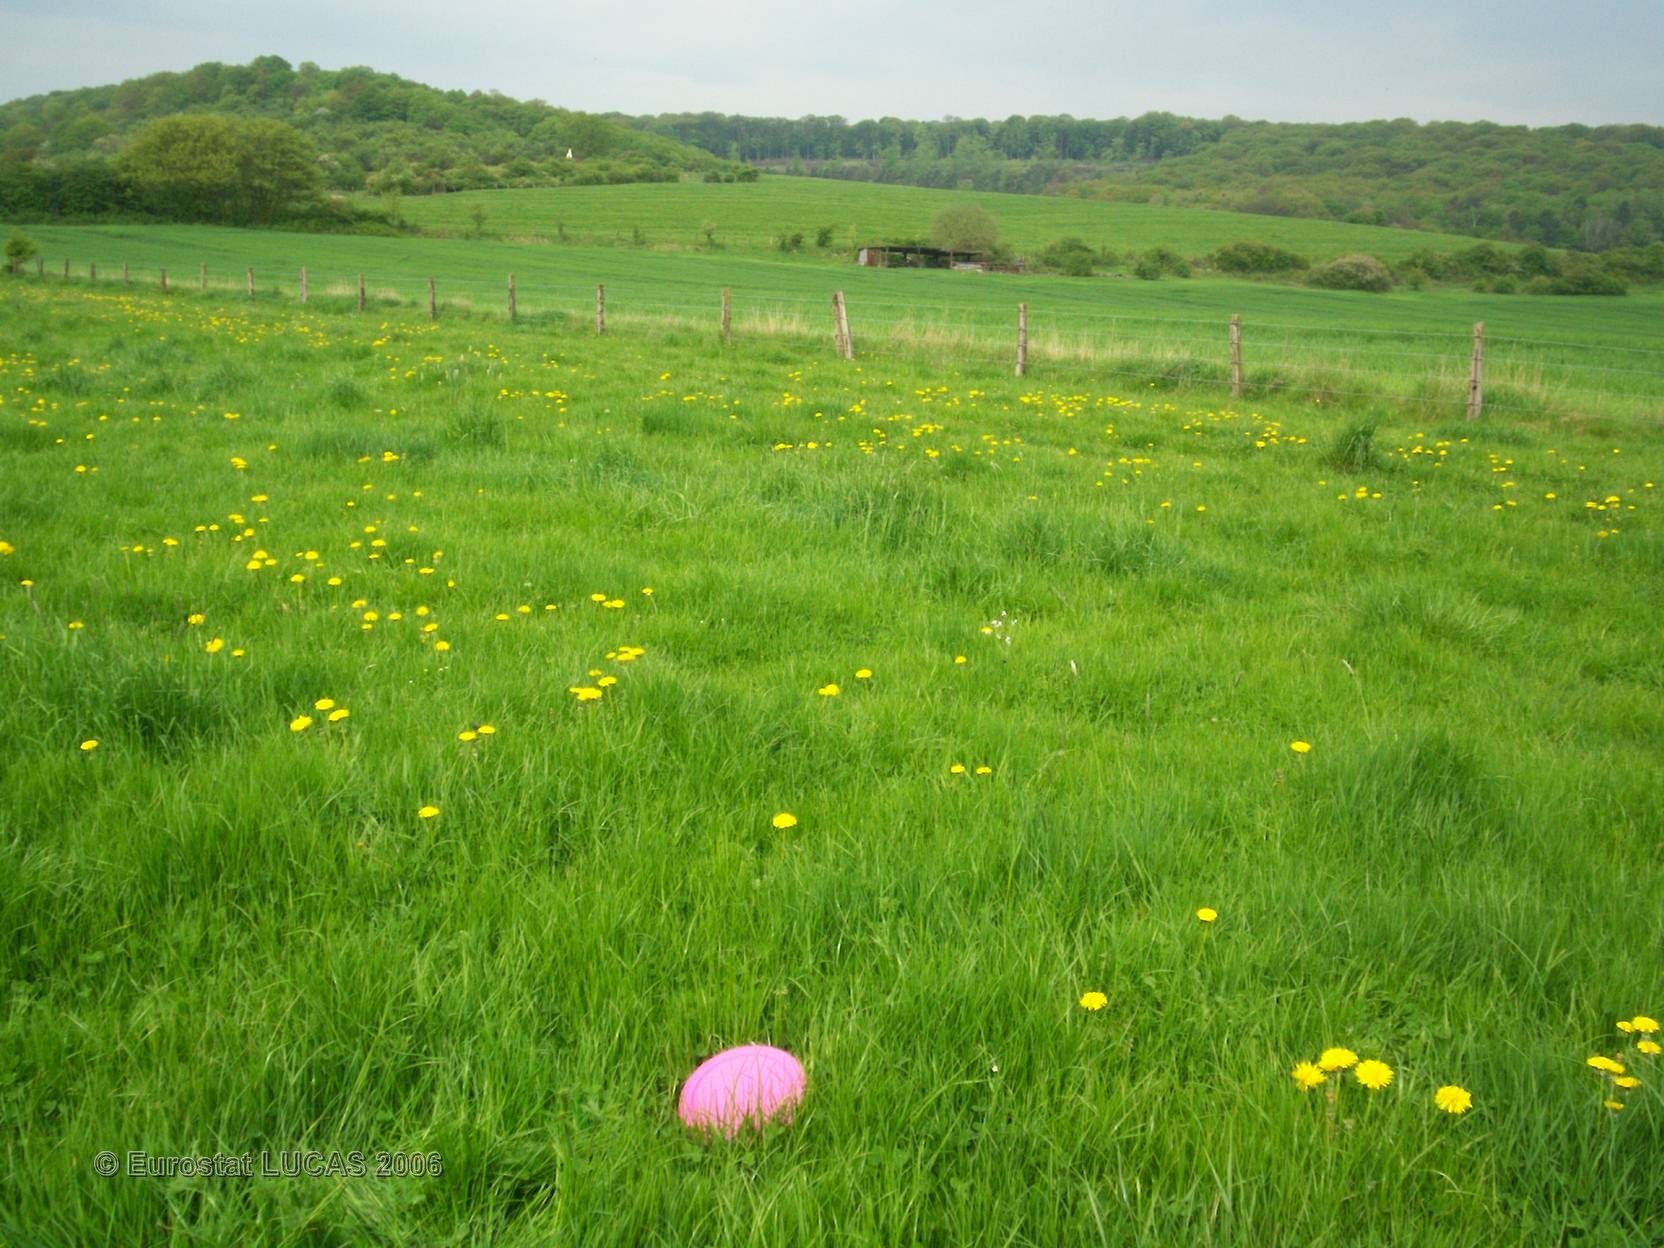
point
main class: Grassland
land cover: Grassland without tree/shrub cover
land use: Agriculture (excluding fallow land and kitchen gardens)
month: May
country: FR
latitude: 49.1748
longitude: 6.4472
